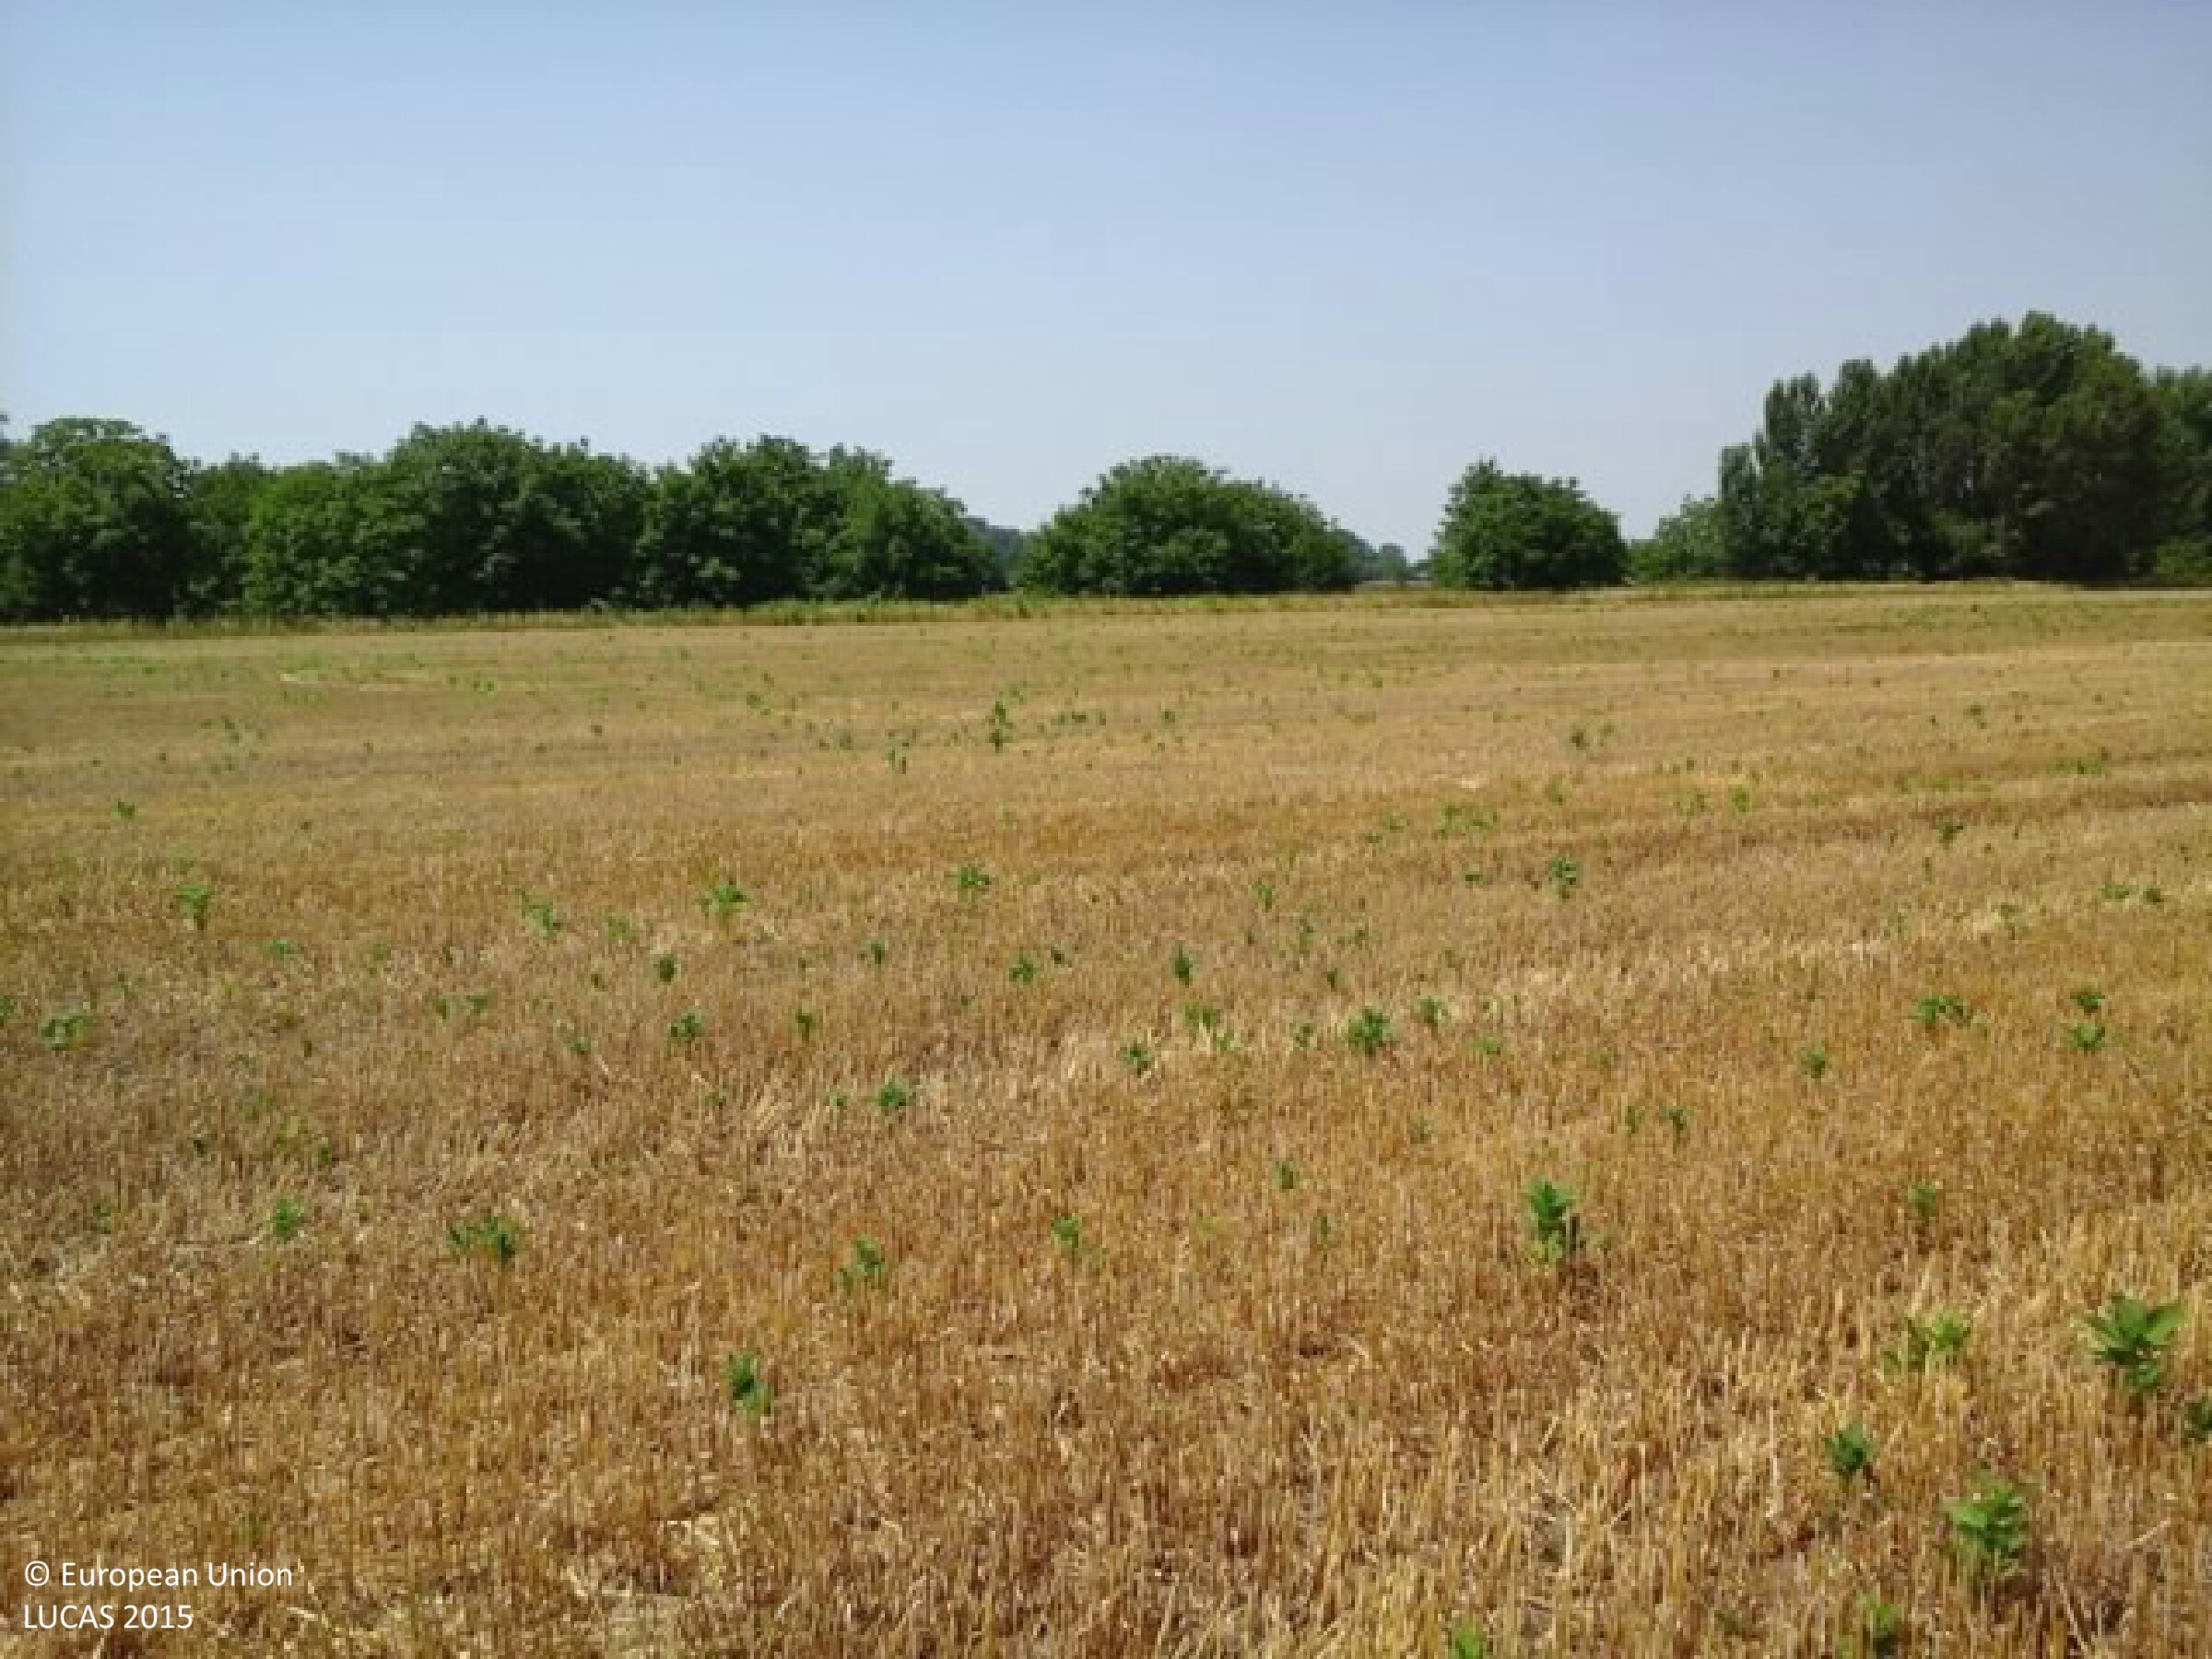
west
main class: Cropland
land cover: Barley
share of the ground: 25 - 50 %
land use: Agriculture (excluding fallow land and kitchen gardens)
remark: Harvested field
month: July
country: HU
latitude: 46.0778
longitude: 19.4415
